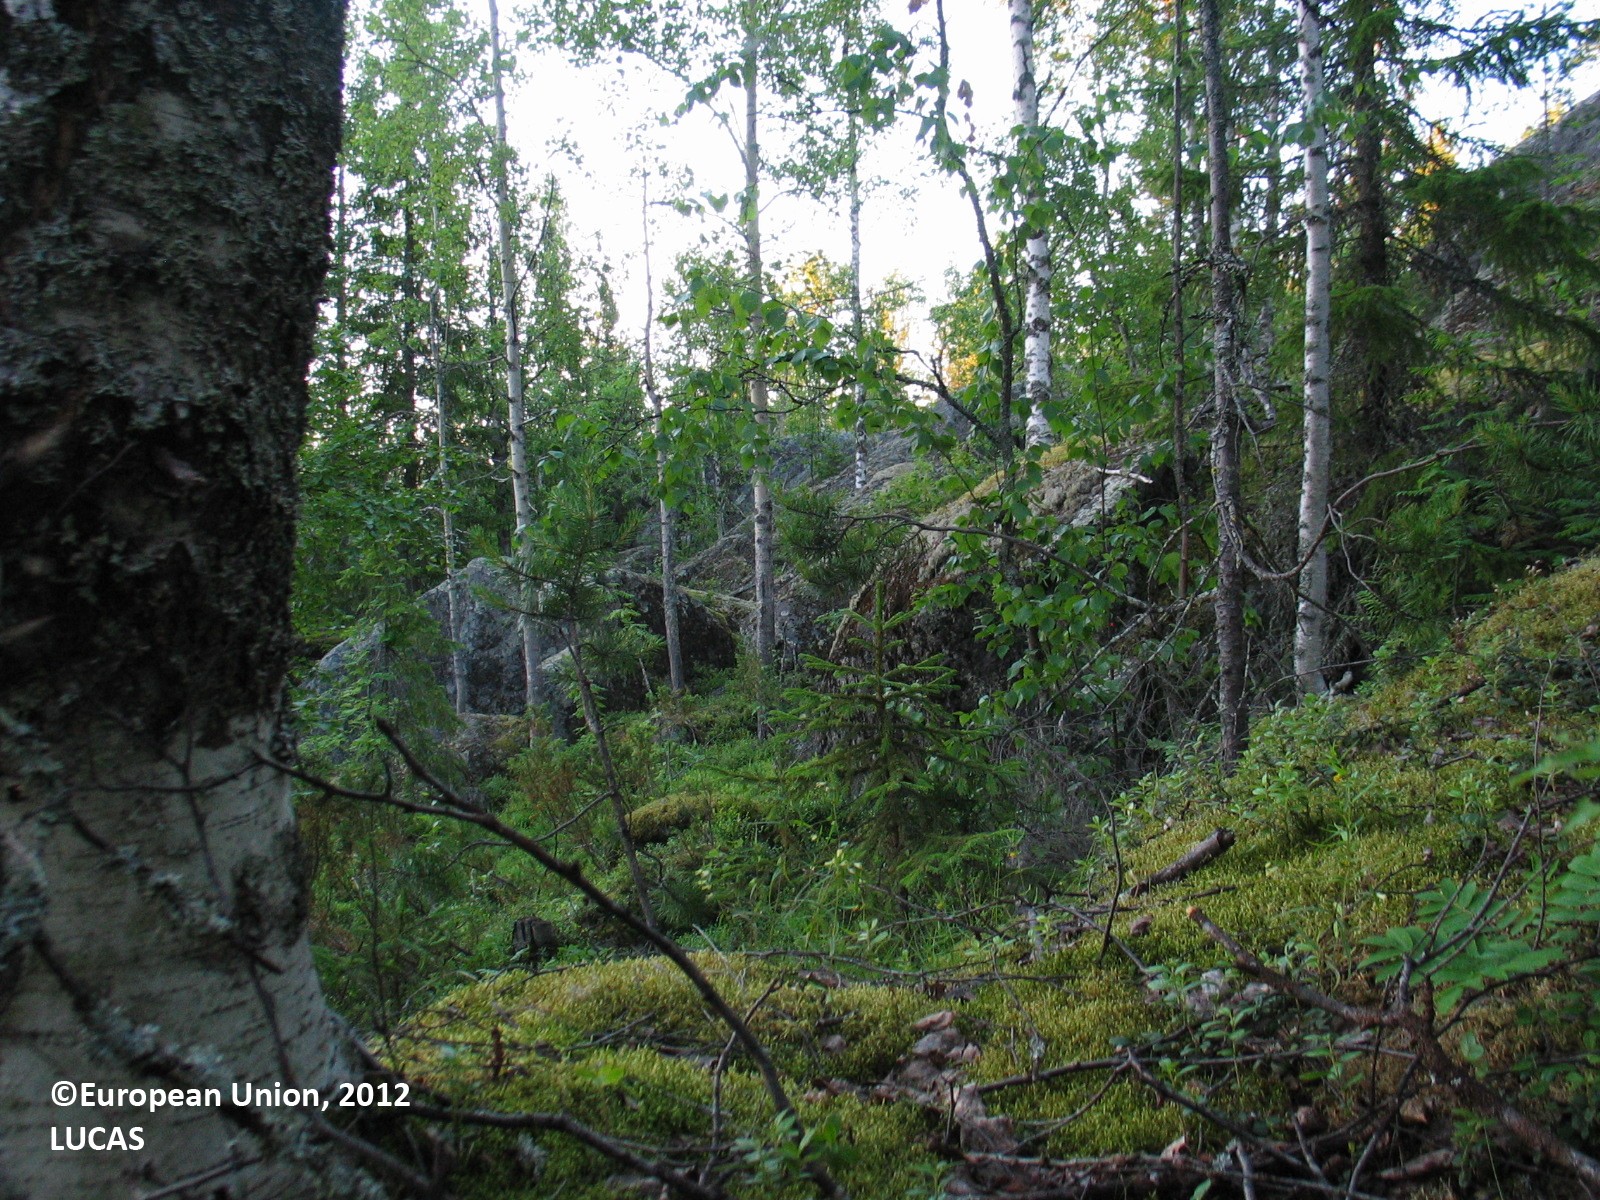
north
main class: Woodland
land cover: Other mixed woodland
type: boreal forest
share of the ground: 25 - 50 %
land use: Forestry
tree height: > 5 m
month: July
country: FI
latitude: 65.8960
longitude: 25.0059
